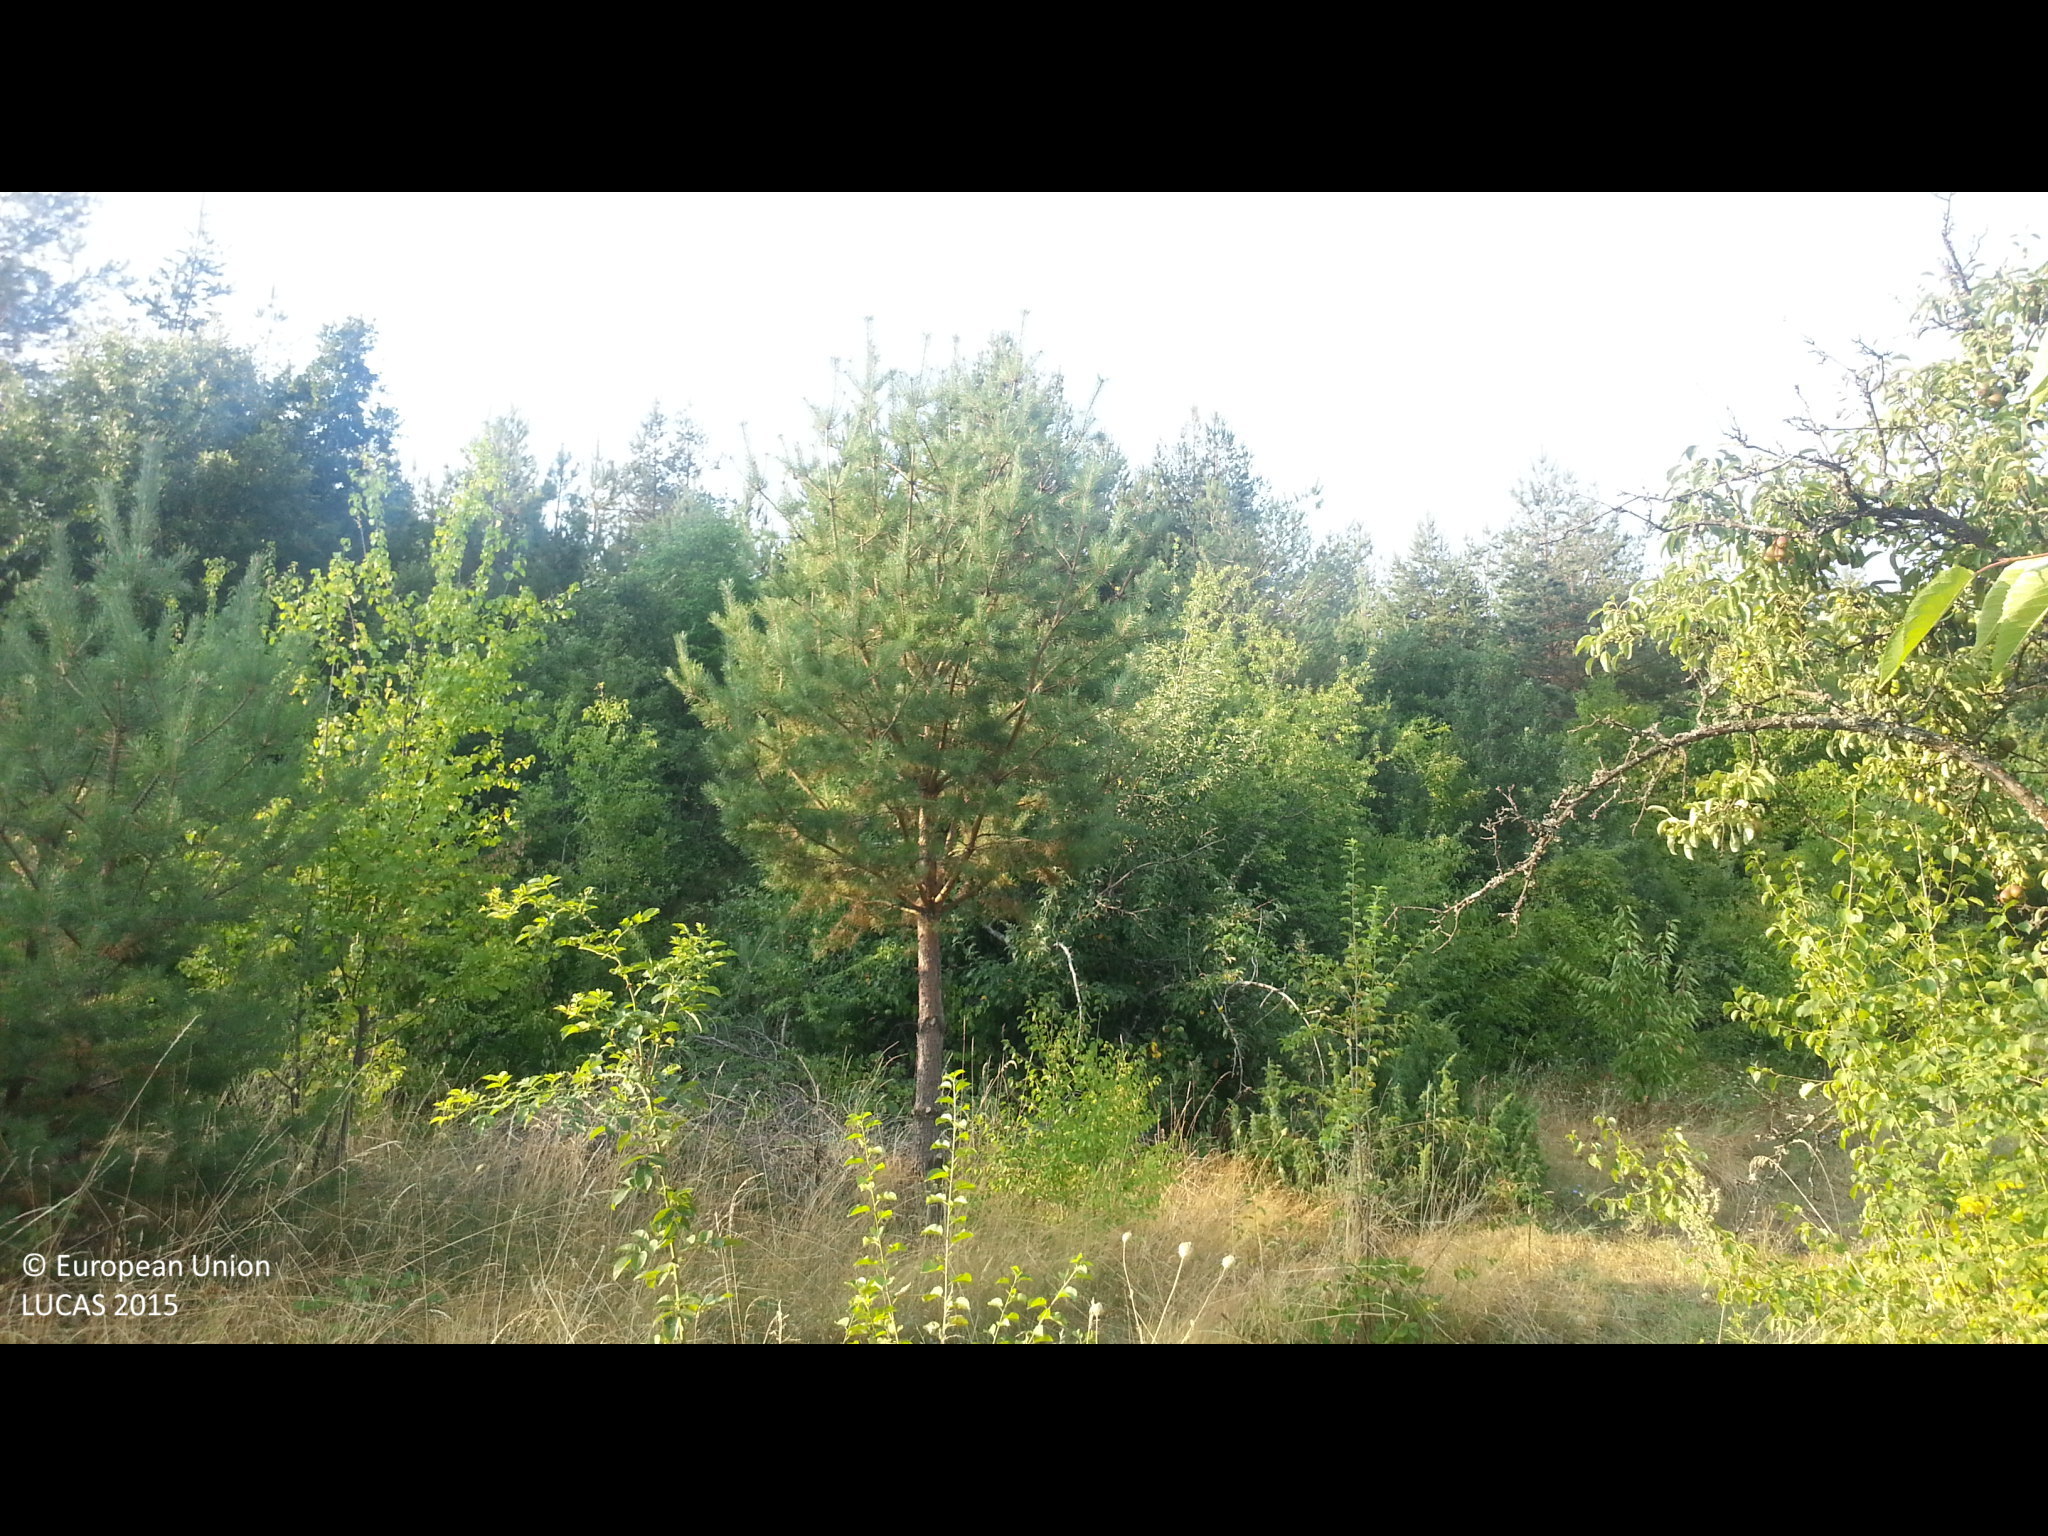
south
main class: Cropland
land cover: Cherry fruit
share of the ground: > 75 %
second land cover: Spontaneously vegetated surfaces
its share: > 75 %
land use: Agriculture (excluding fallow land and kitchen gardens)
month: August
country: BG
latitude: 42.4025
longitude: 22.6704
